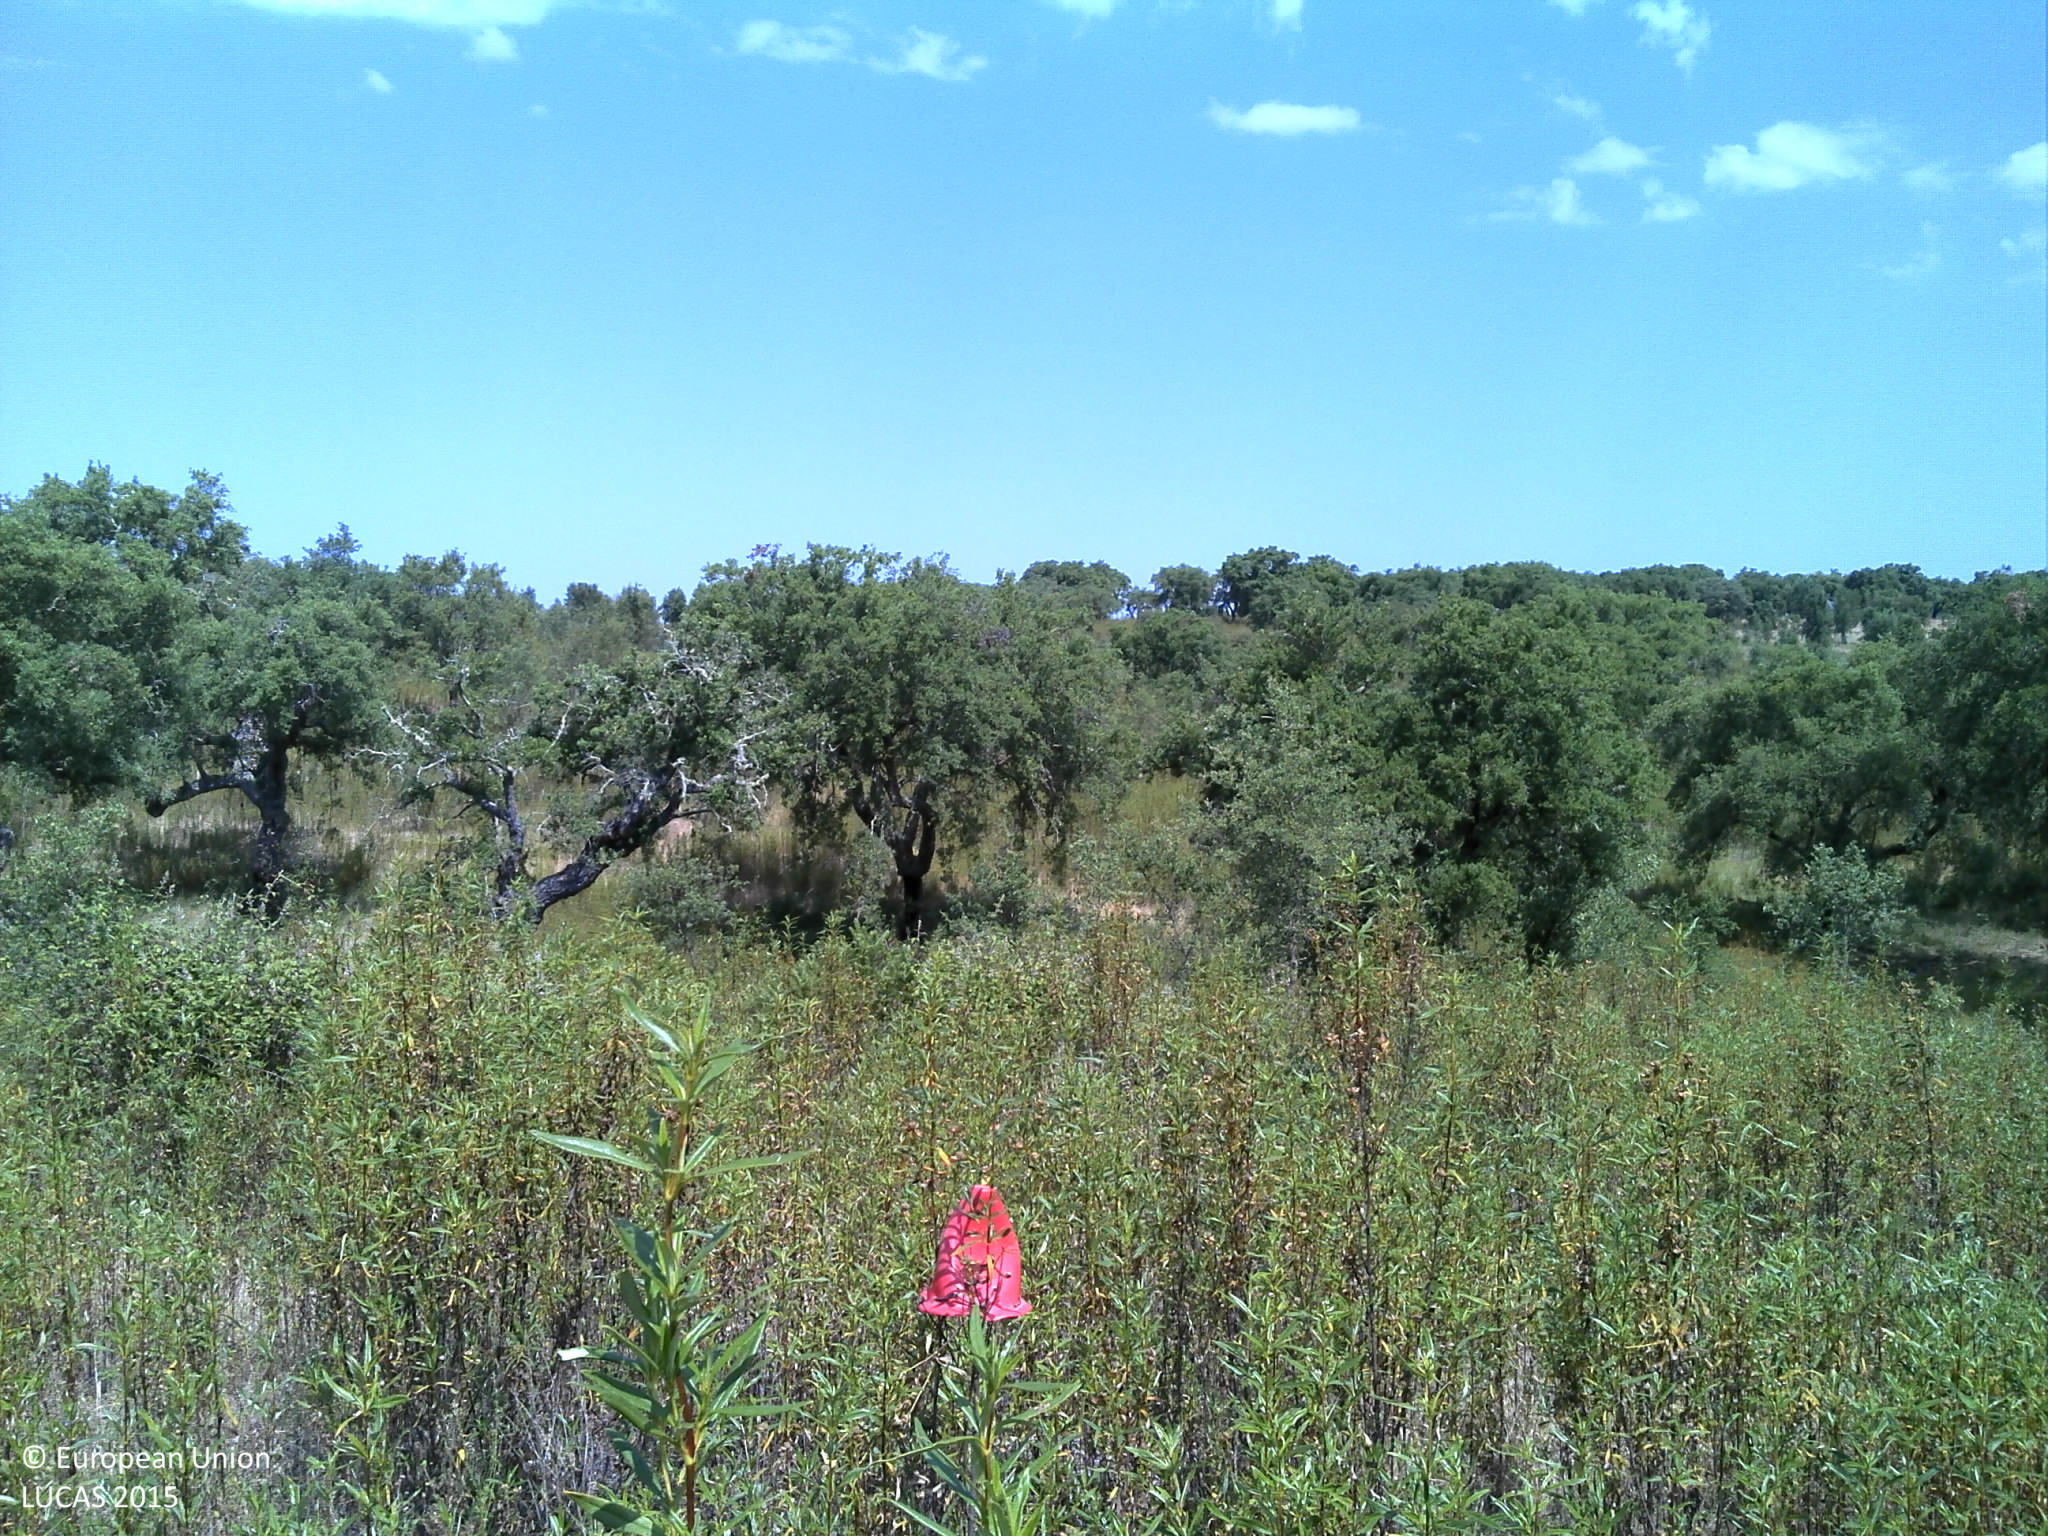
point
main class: Woodland
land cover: Broadleaved woodland
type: broadleaved evergreen forest
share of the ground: 10 - 25 %
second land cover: Shrubland without tree cover
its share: > 75 %
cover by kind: shrubs 75 %, broadleaved forest trees 20 %, herbaceous plants 5 %
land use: Forestry
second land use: Agriculture (excluding fallow land and kitchen gardens)
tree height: > 5 m
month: May
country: PT
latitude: 38.8913
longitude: -7.8567
